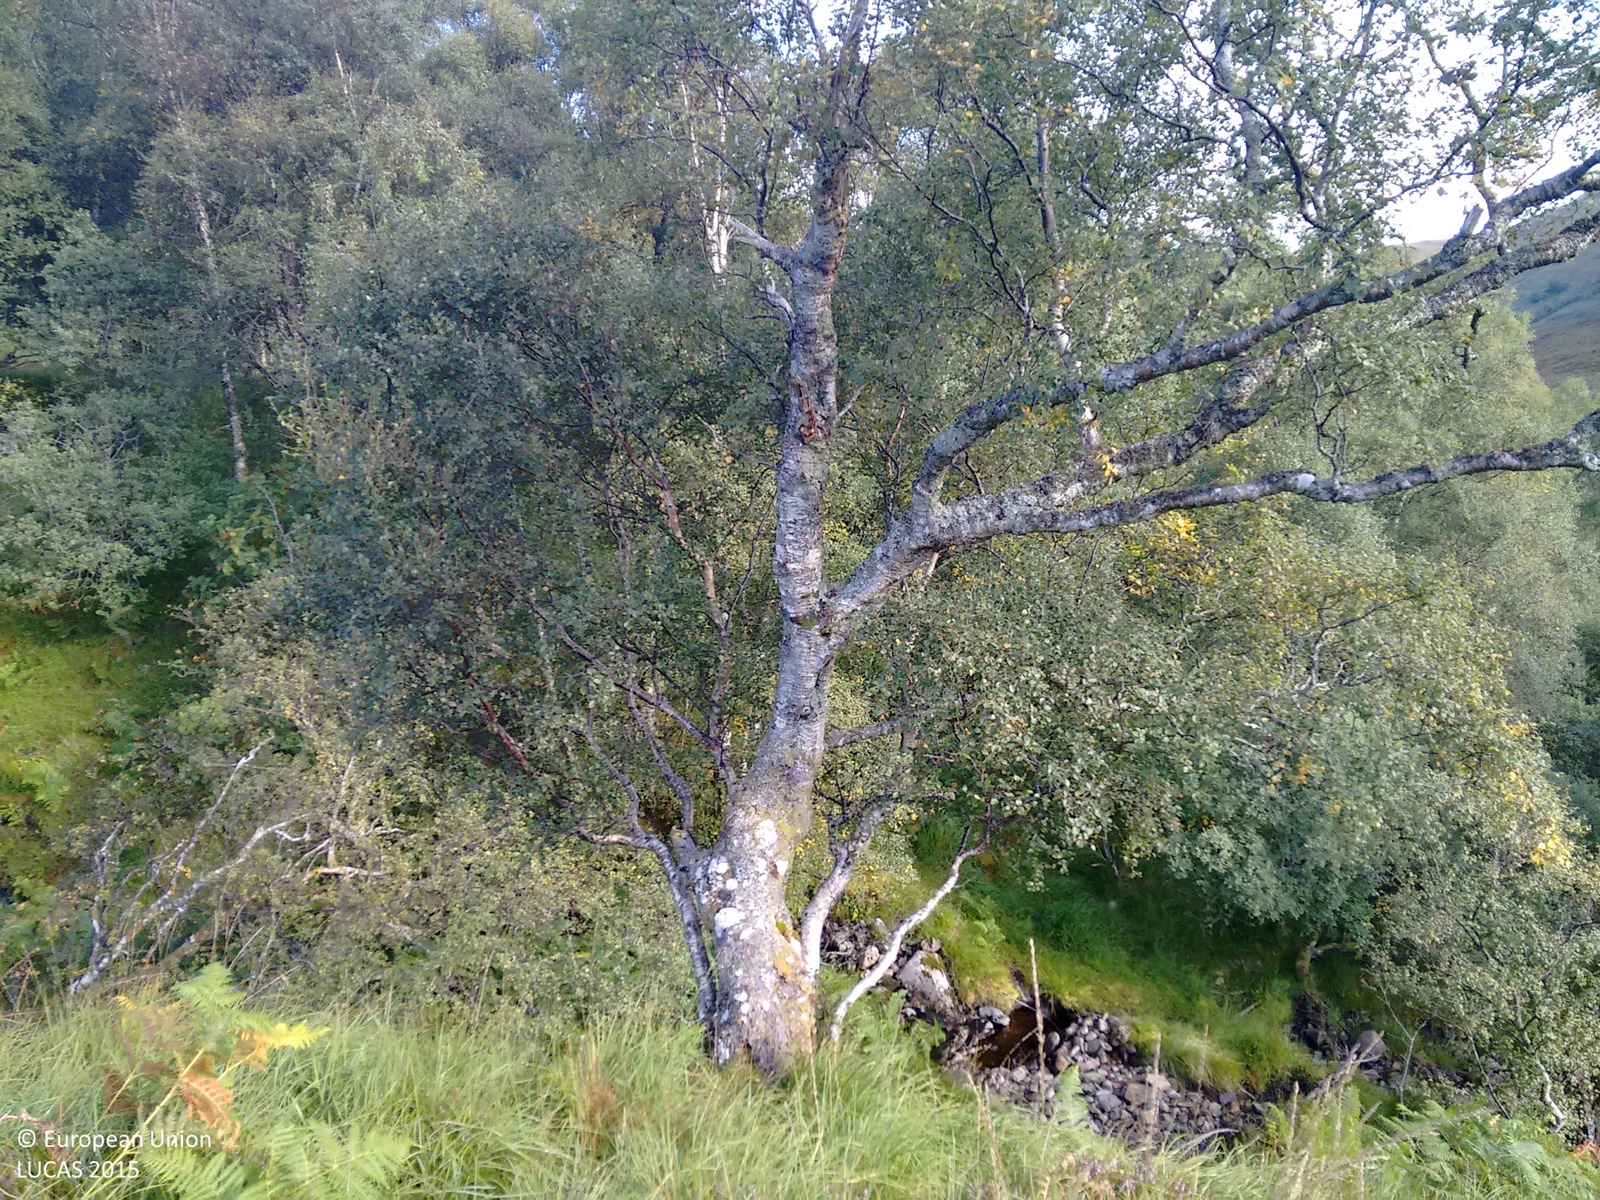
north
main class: Shrubland
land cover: Shrubland without tree cover
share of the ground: > 75 %
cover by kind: shrubs 90 %, herbaceous plants 10 %
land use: Agriculture (excluding fallow land and kitchen gardens)
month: September
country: GB
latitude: 57.7925
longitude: -5.1605
